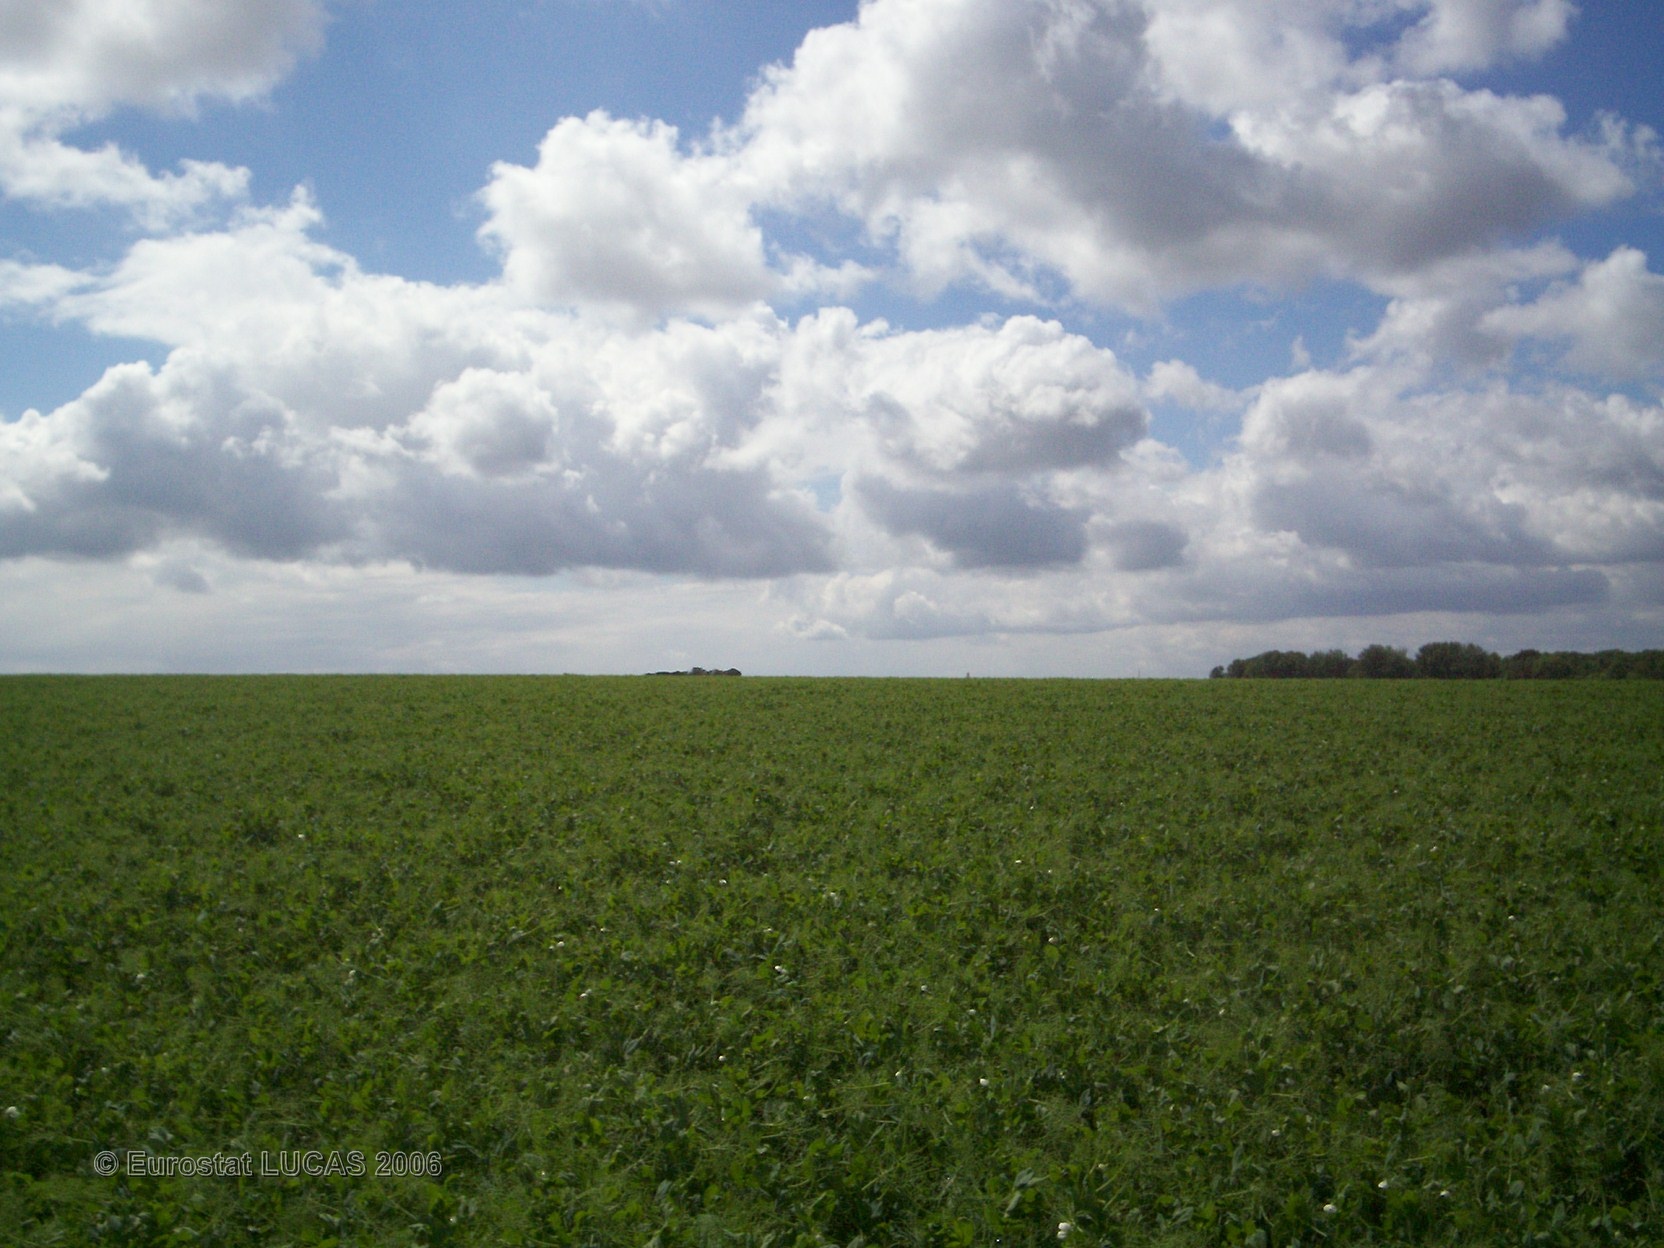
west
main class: Cropland
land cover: Dry pulses
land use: Agriculture (excluding fallow land and kitchen gardens)
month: May
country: FR
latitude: 49.1972
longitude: 2.7851
